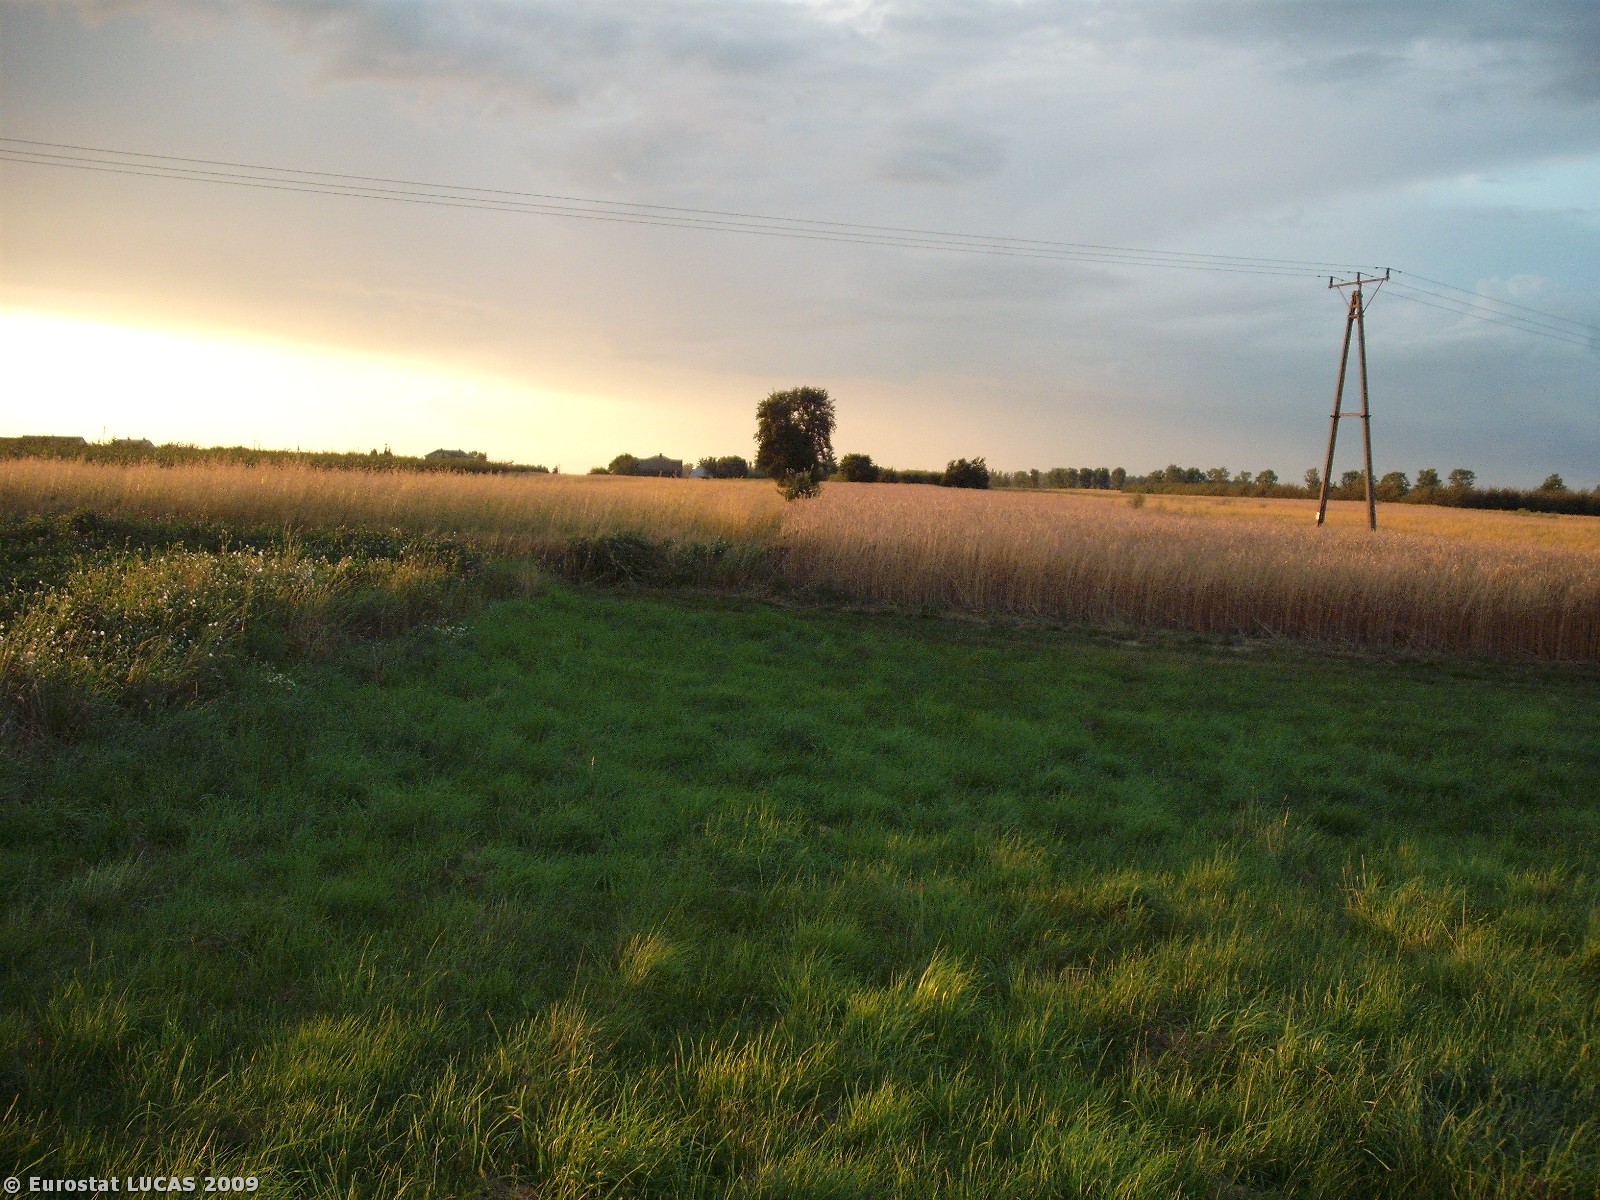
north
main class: Grassland
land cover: Grassland without tree/shrub cover
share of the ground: > 75 %
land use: Agriculture (excluding fallow land and kitchen gardens)
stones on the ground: < 10 %
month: July
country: PL
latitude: 51.1321
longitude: 21.4397
